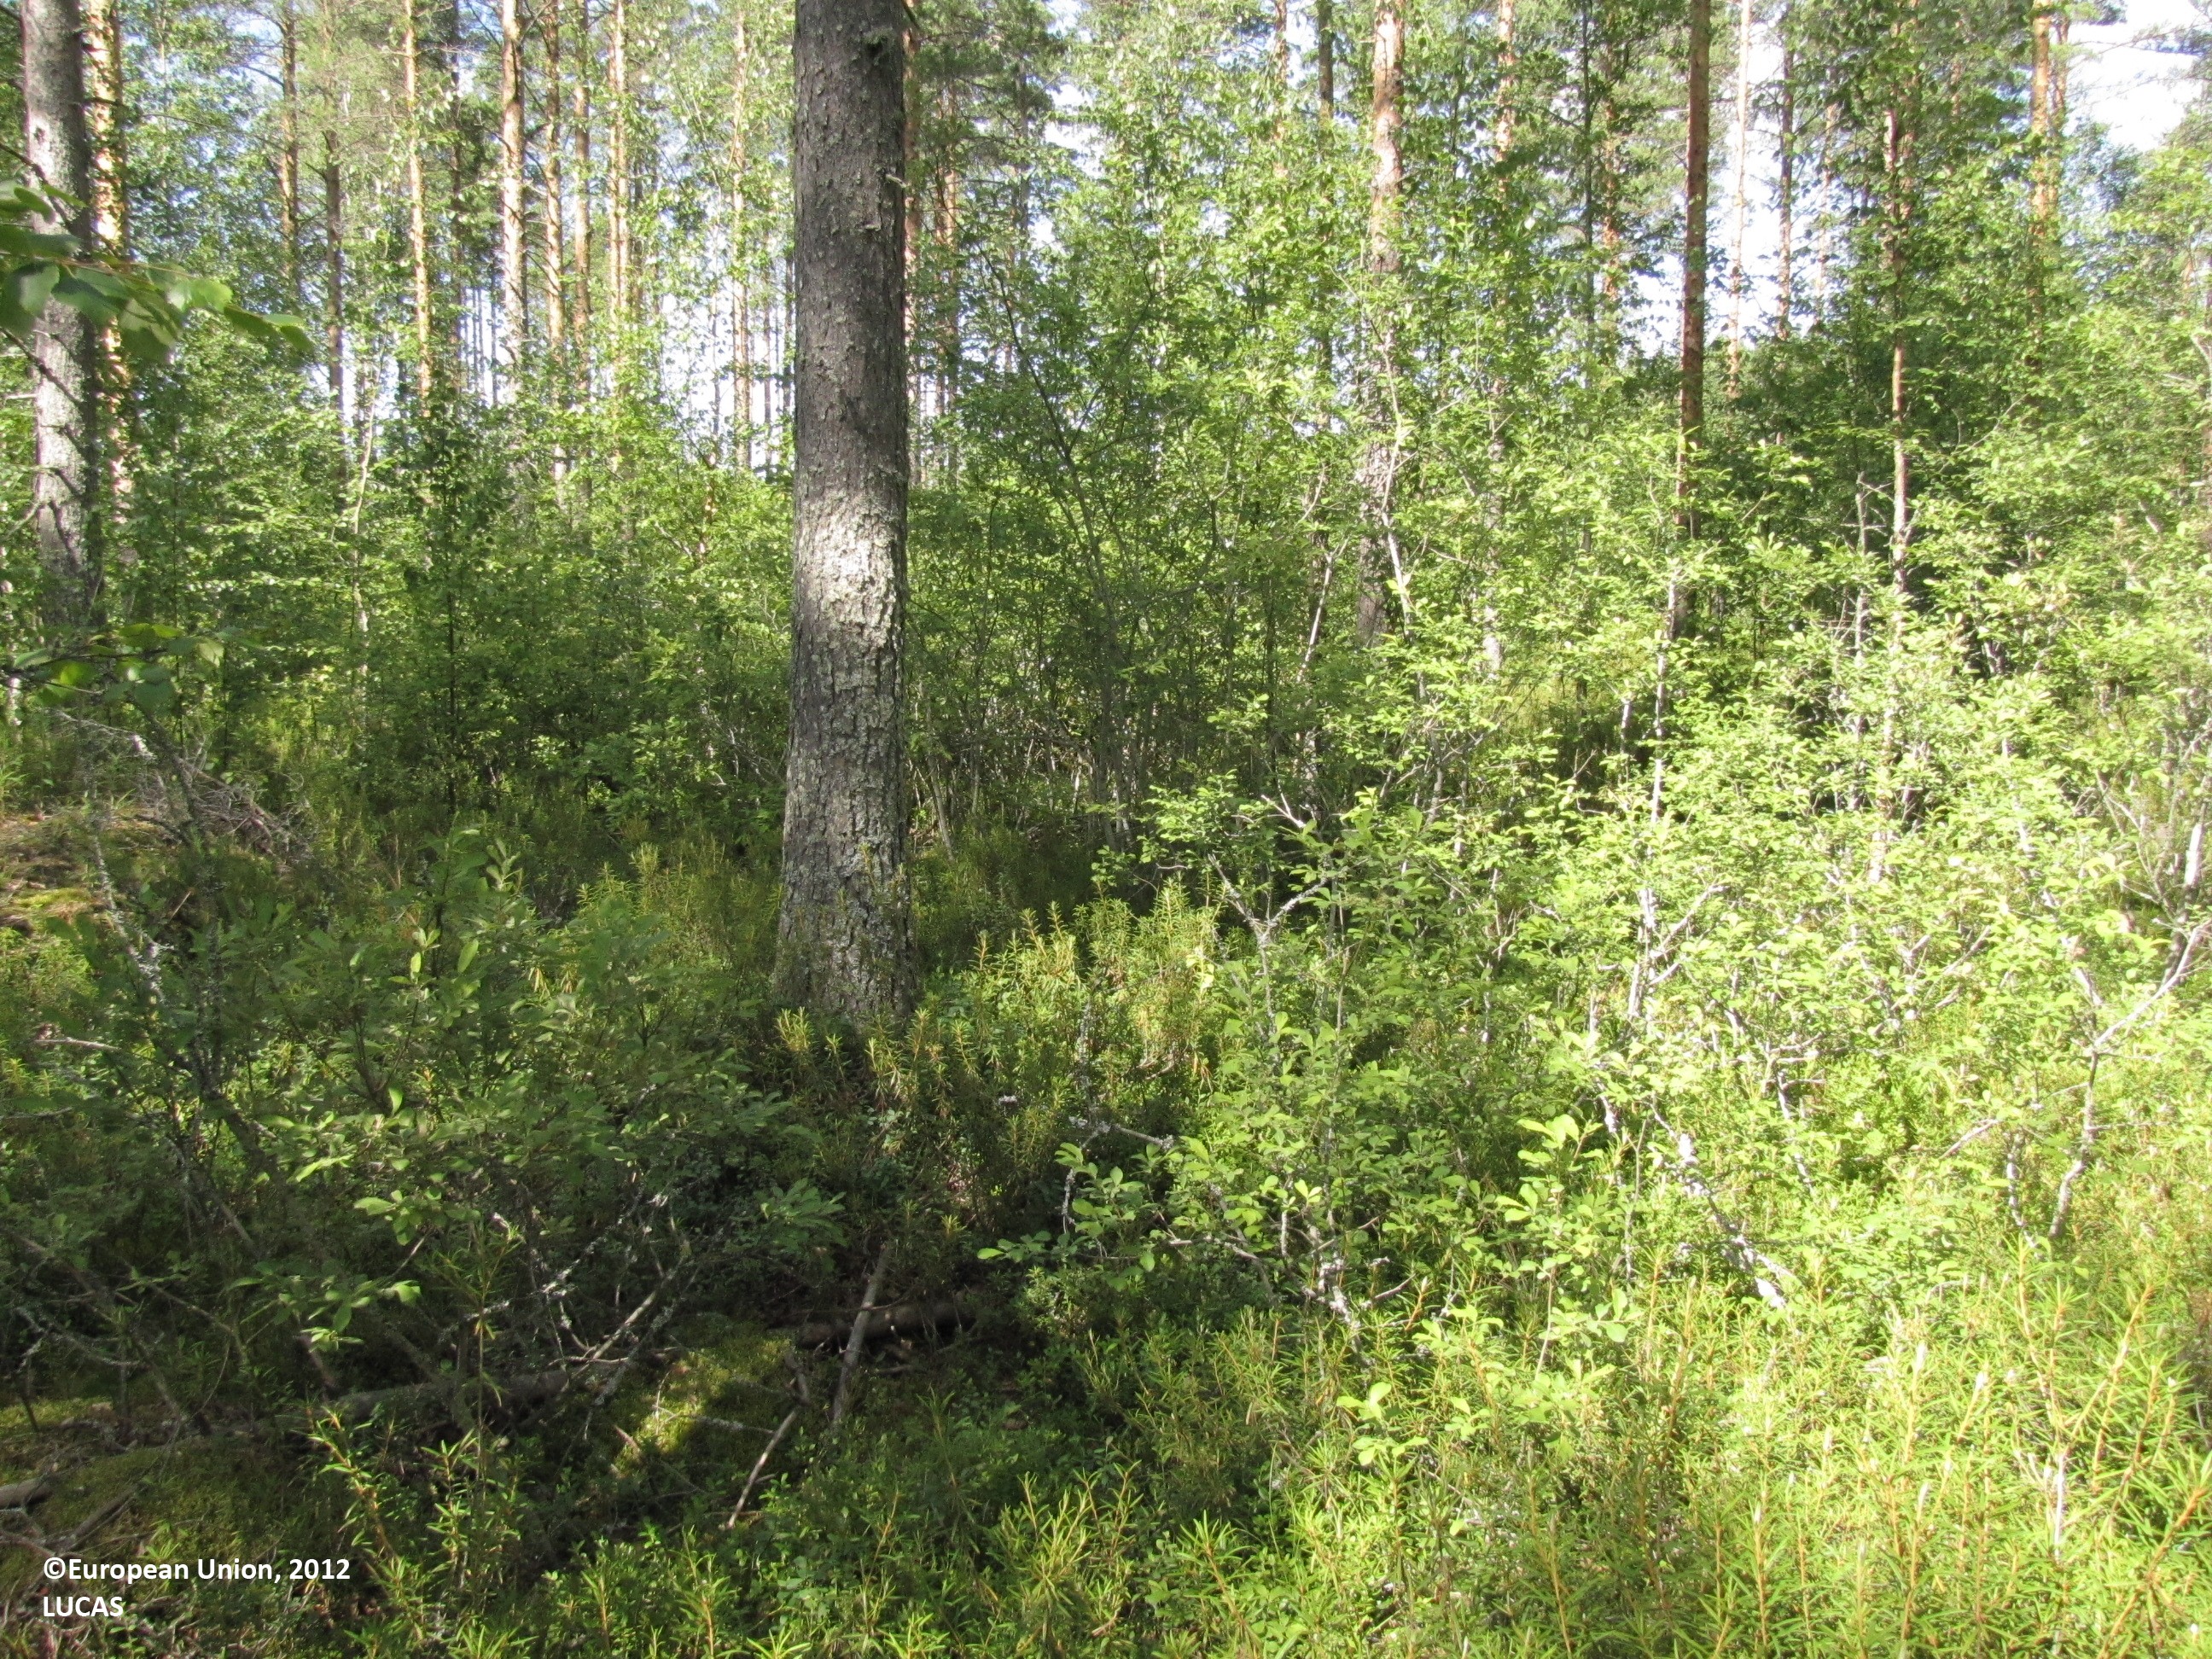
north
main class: Woodland
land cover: Pine dominated coniferous woodland
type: boreal forest
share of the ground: 50 - 75 %
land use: Forestry
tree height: > 5 m
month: July
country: FI
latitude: 62.4398
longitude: 23.1035
